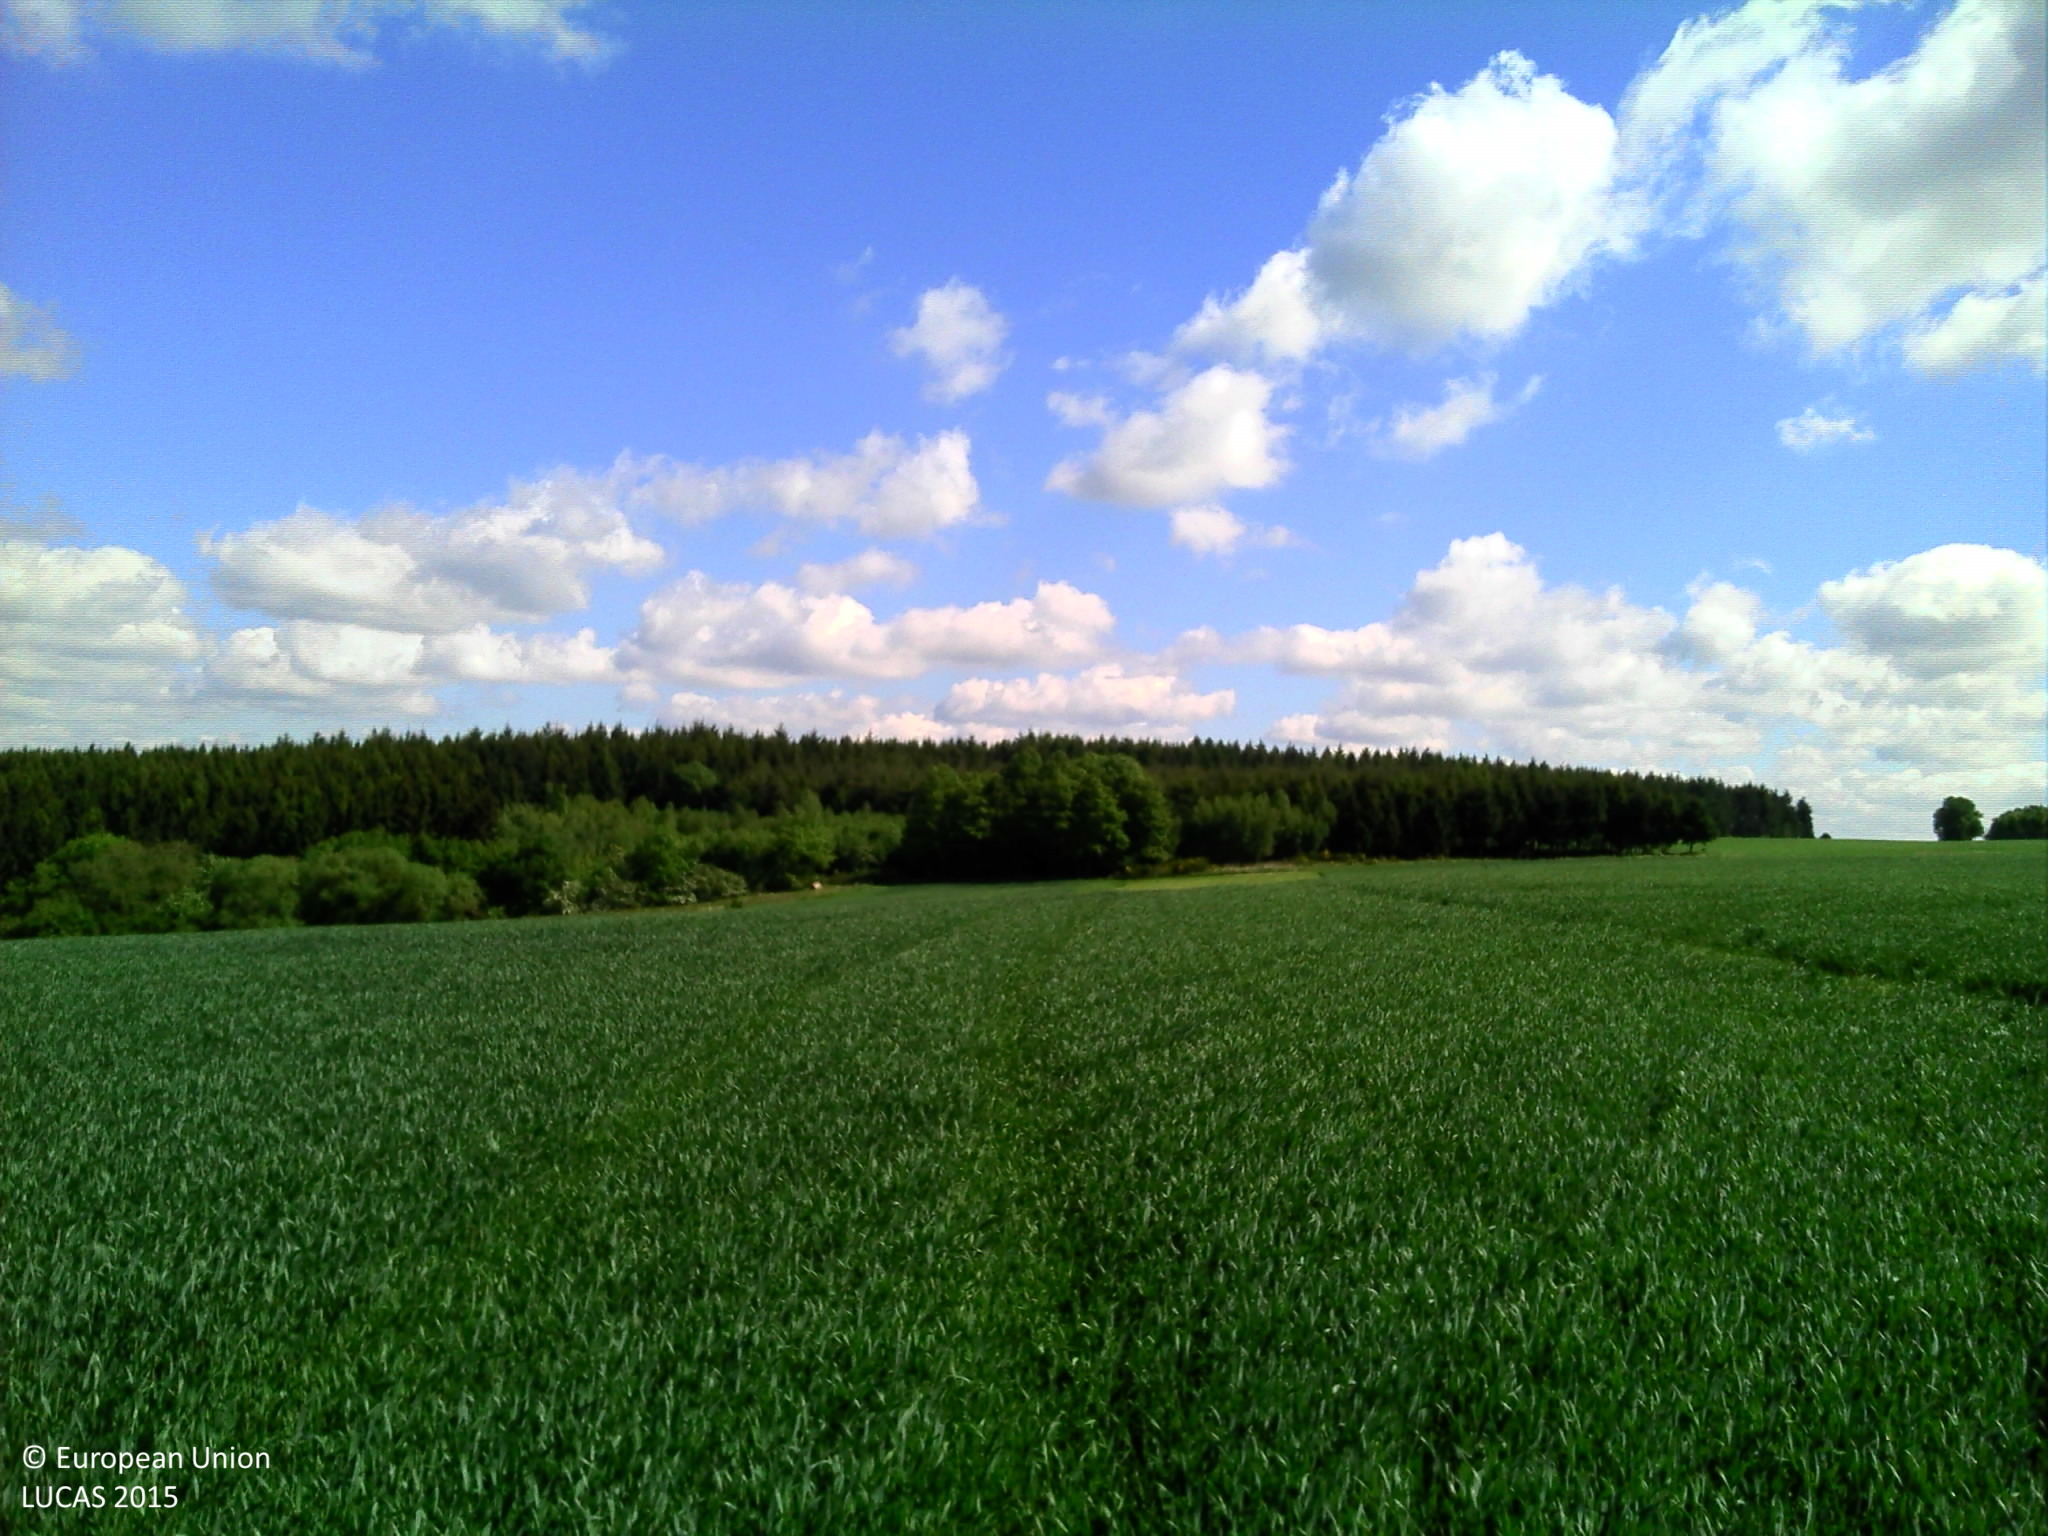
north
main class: Cropland
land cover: Common wheat
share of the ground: > 75 %
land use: Agriculture (excluding fallow land and kitchen gardens)
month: May
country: LU
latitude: 50.0438
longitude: 6.0474
